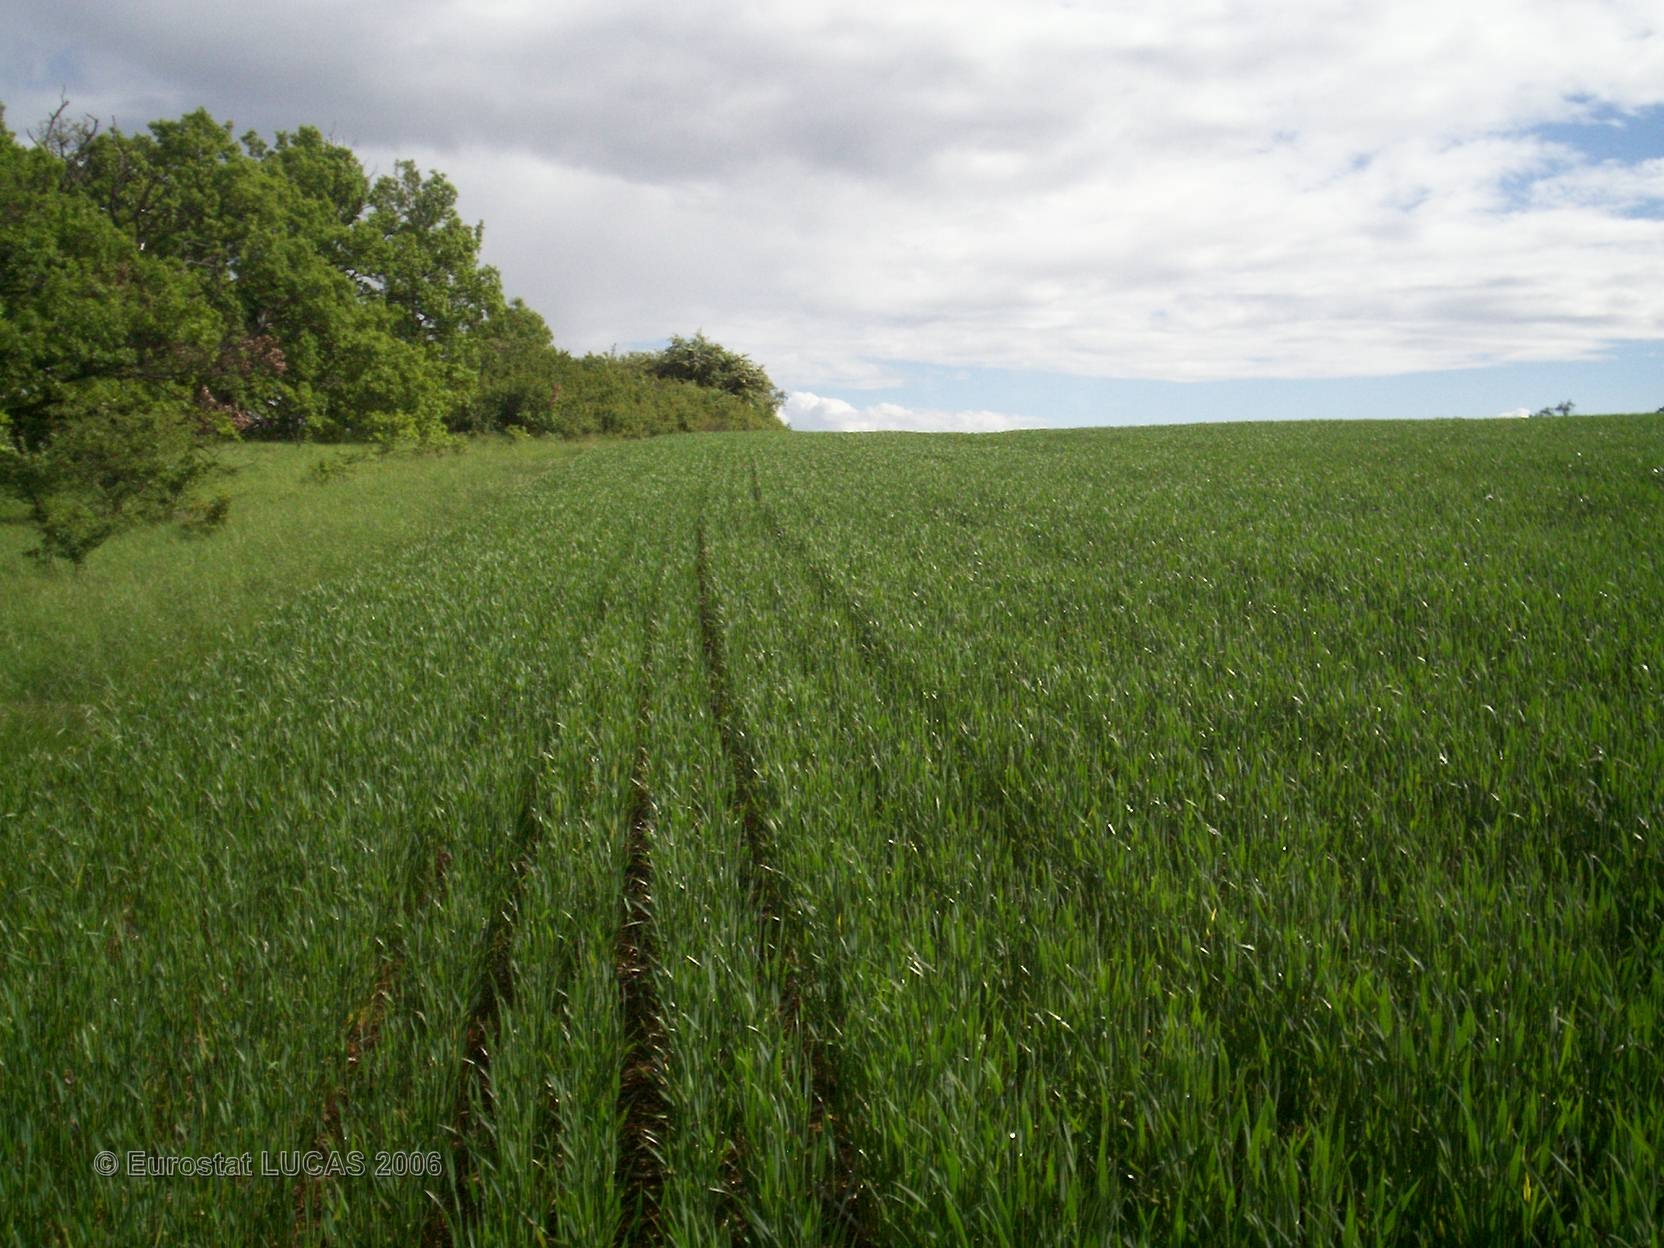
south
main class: Cropland
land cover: Common wheat
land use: Agriculture (excluding fallow land and kitchen gardens)
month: May
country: FR
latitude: 46.9766
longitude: 4.6767
